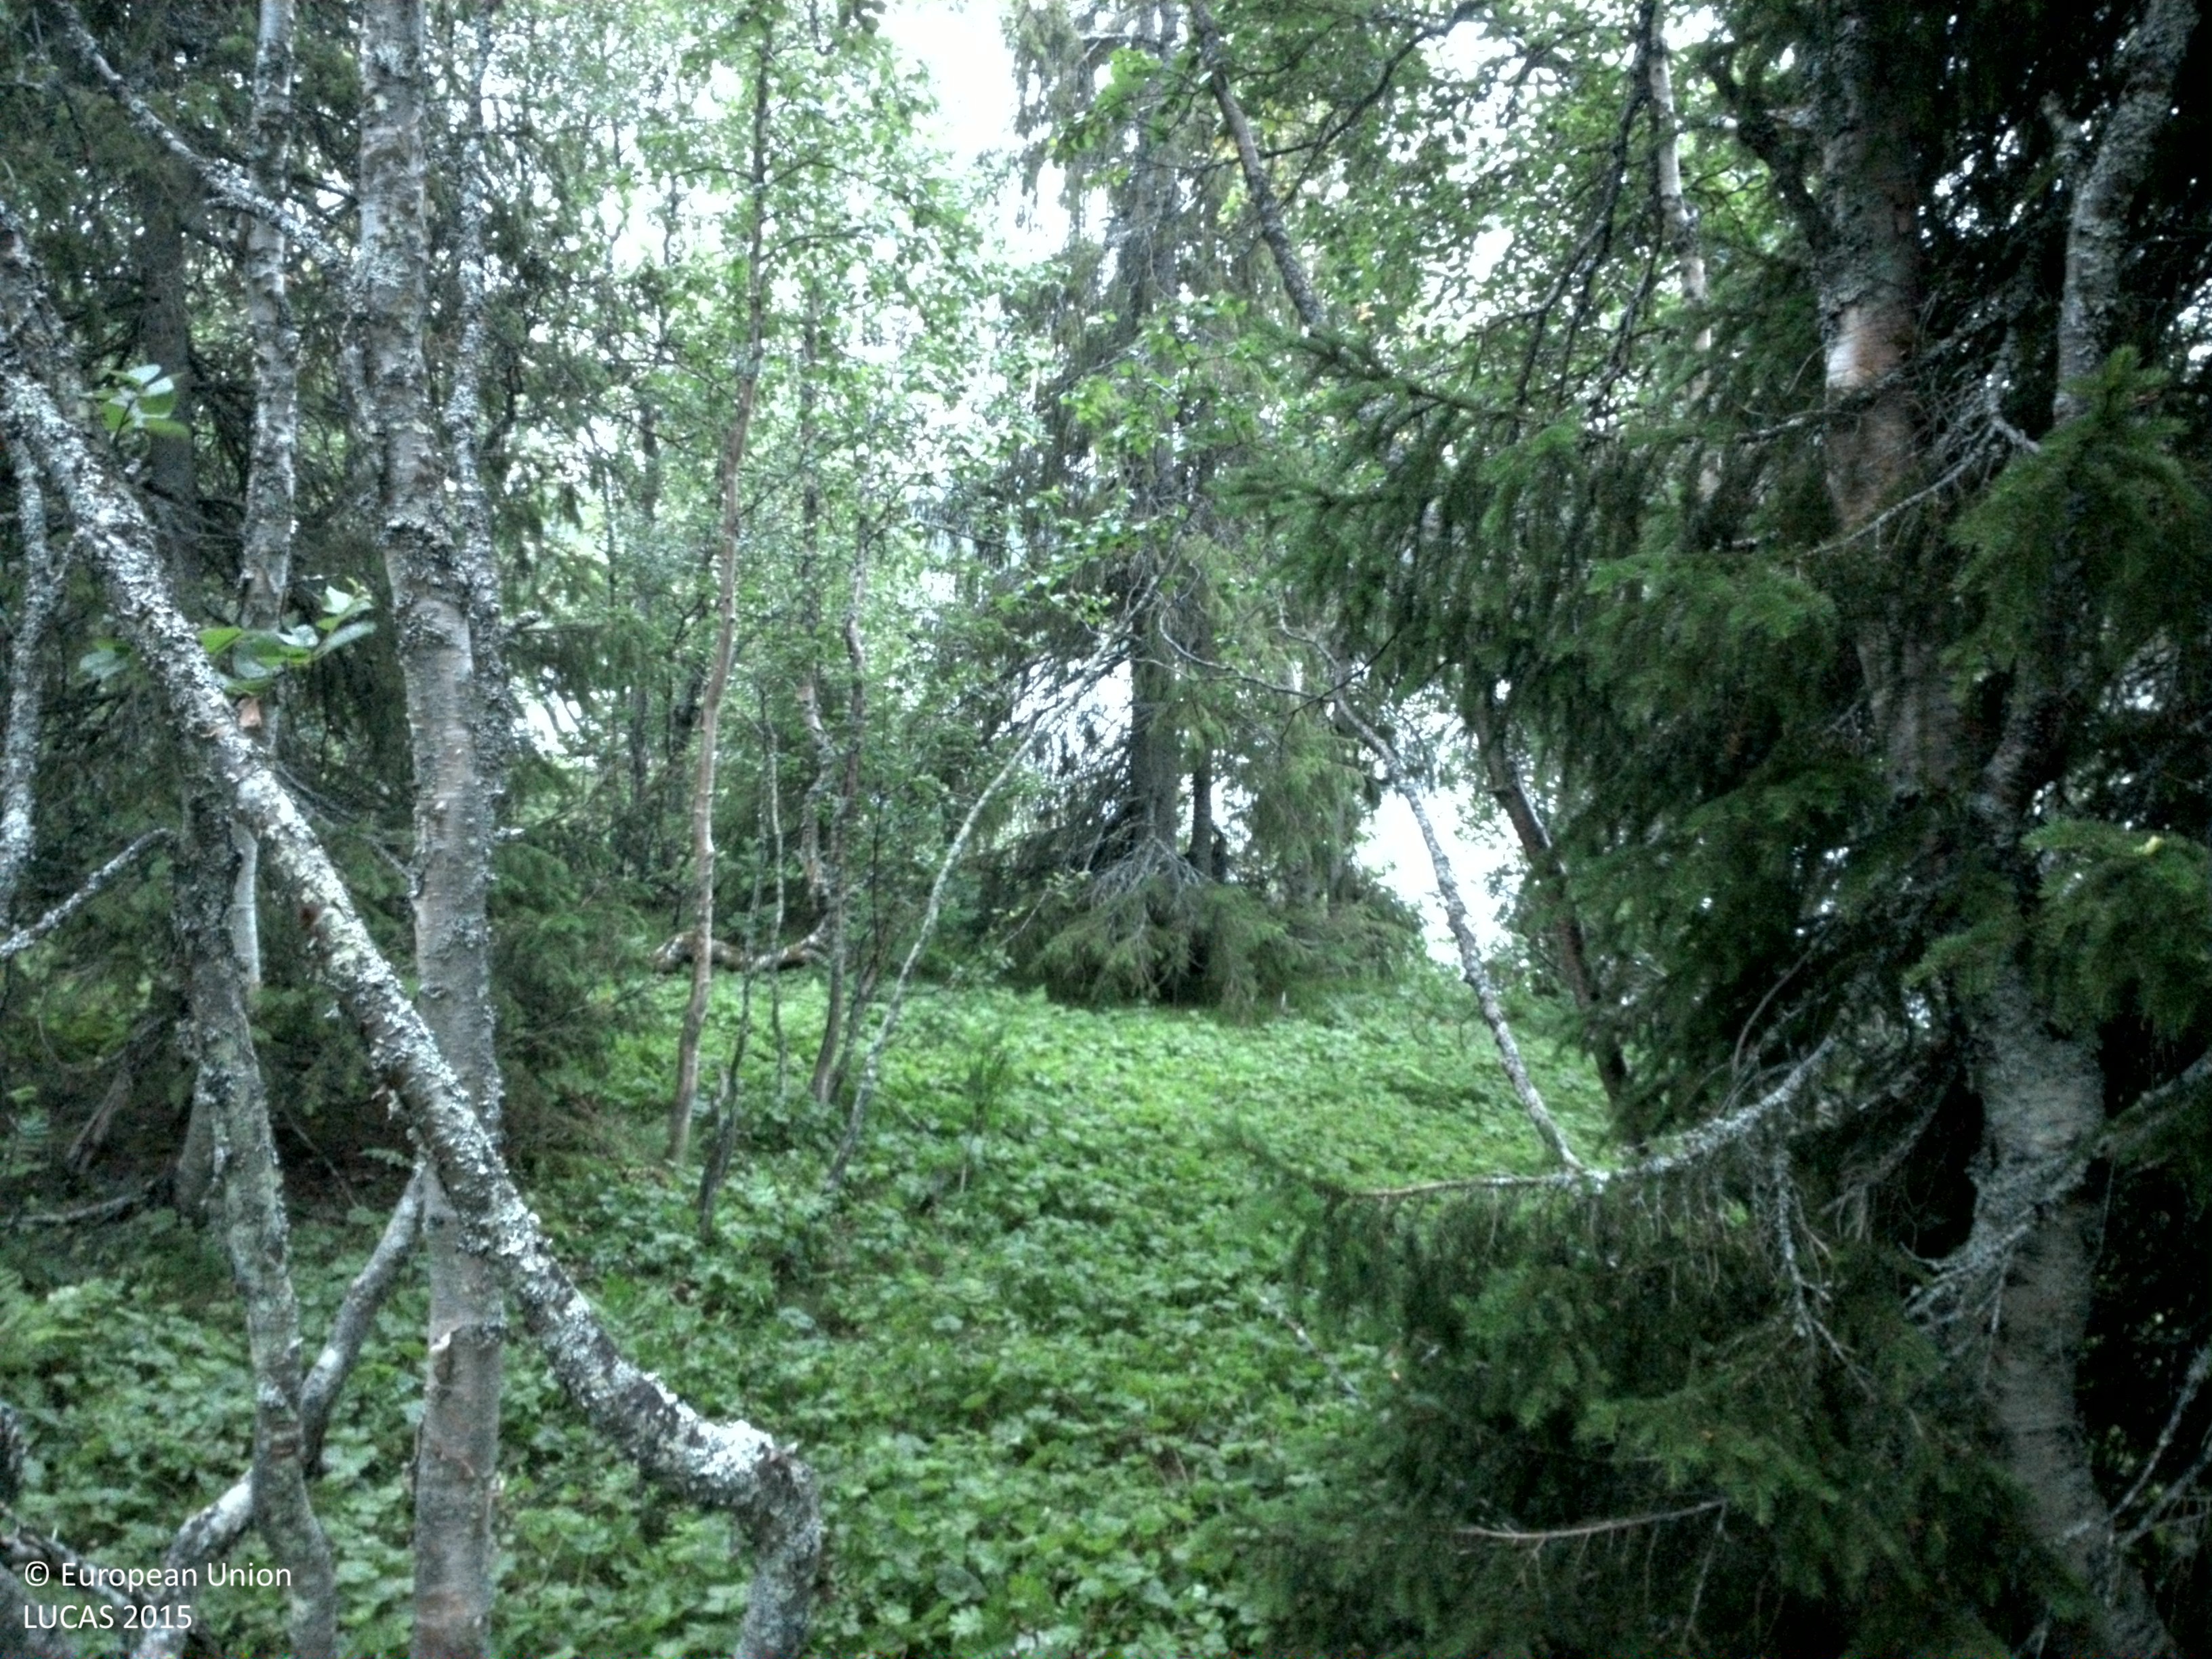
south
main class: Woodland
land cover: Spruce dominated mixed woodland
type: boreal forest
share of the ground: 50 - 75 %
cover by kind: herbaceous plants 45 %, broadleaved forest trees 40 %, coniferous forest trees 15 %
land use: Amenities, museums, leisure
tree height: > 5 m
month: August
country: SE
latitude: 64.9686
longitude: 15.6227
